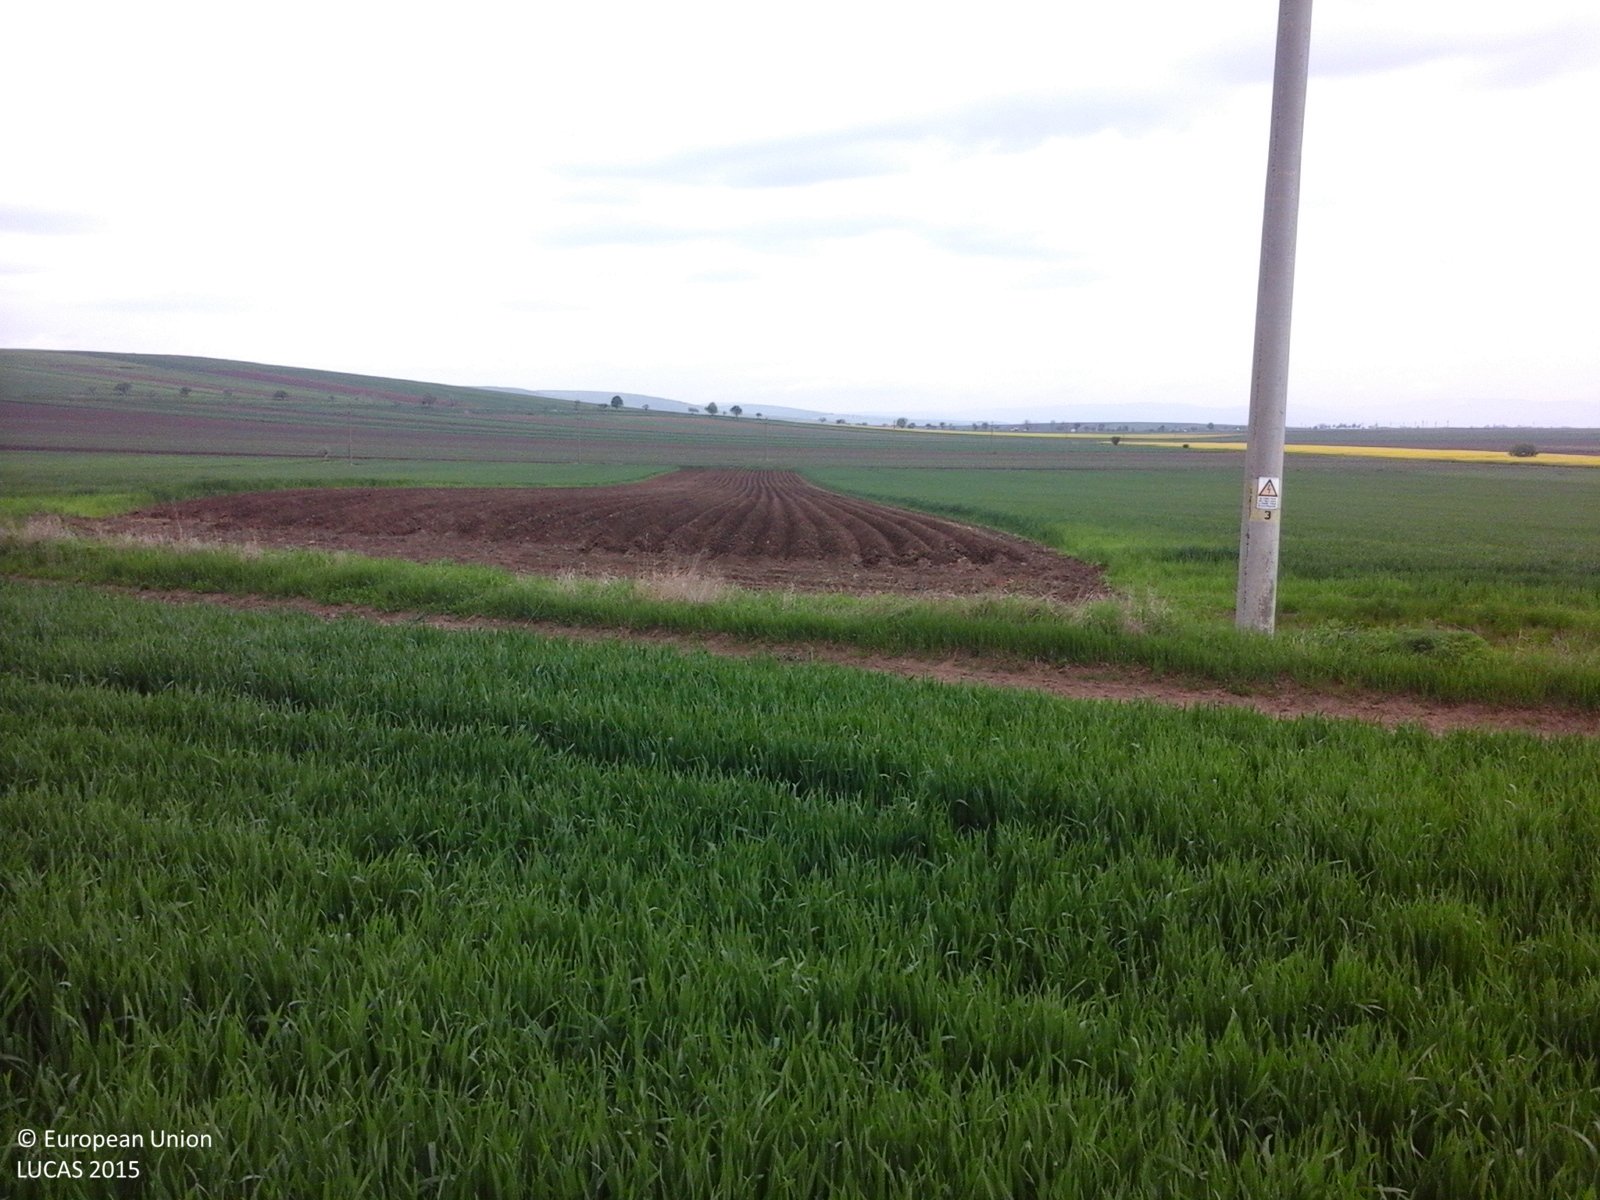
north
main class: Cropland
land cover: Common wheat
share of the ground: > 75 %
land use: Agriculture (excluding fallow land and kitchen gardens)
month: May
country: RO
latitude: 45.9059
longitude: 26.0106
